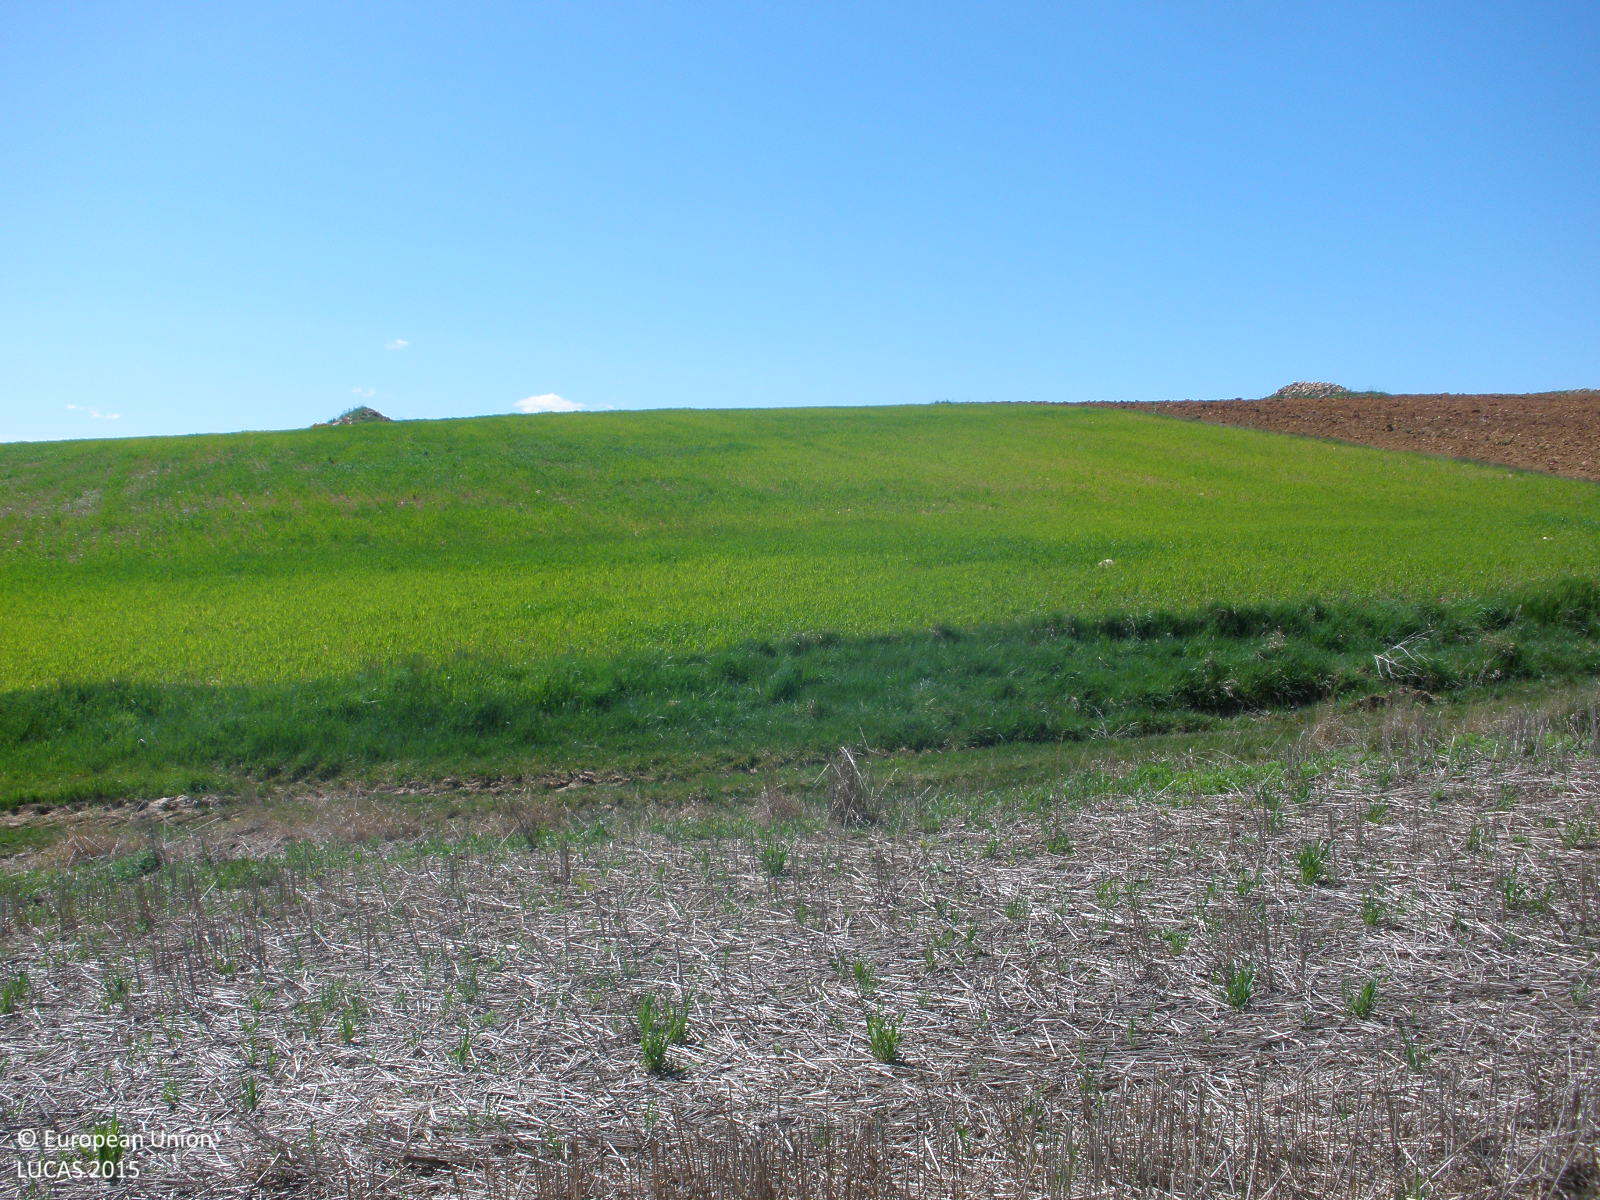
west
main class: Grassland
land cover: Spontaneously vegetated surfaces
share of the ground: 25 - 50 %
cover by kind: unconsolidated bare surface 75 %, herbaceous plants 25 %
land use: Agriculture (excluding fallow land and kitchen gardens)
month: May
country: ES
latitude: 40.7271
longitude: -0.7985
